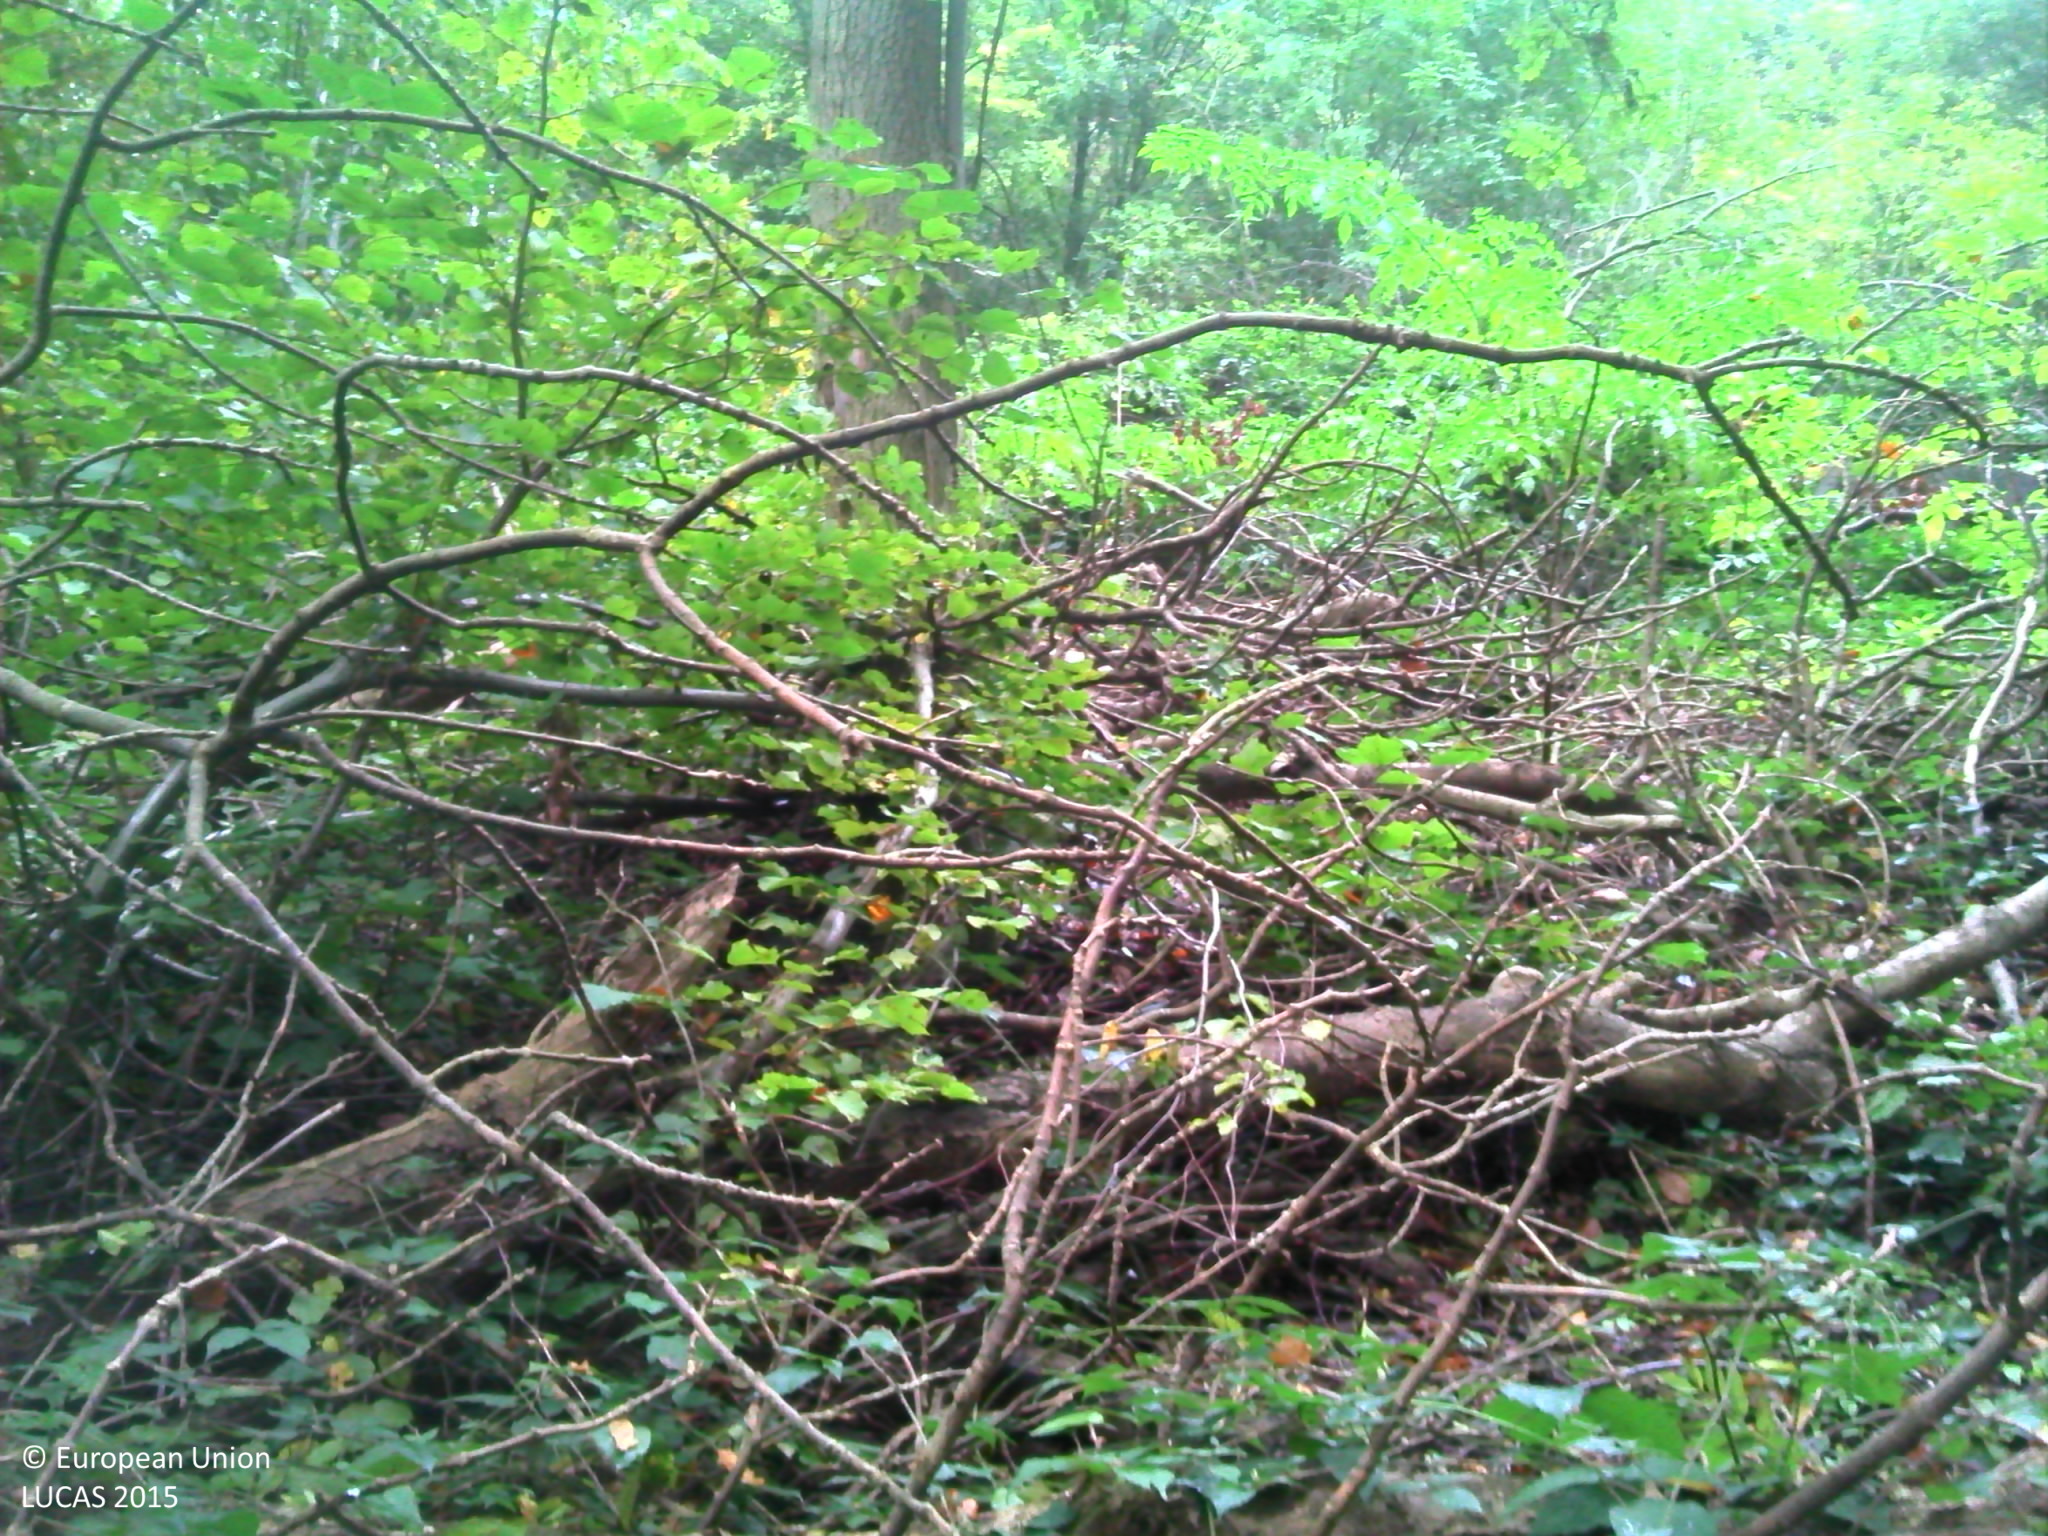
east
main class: Woodland
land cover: Broadleaved woodland
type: mesophytic deciduous forest
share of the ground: > 75 %
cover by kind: broadleaved forest trees 60 %, herbaceous plants 30 %, shrubs 10 %
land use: Forestry
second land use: Amenities, museums, leisure
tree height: > 5 m
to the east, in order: Broadleaved woodland; Tracks; Broadleaved woodland; Tracks; Fences; Broadleaved woodland
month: October
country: BE
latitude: 50.8886
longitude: 4.2947
